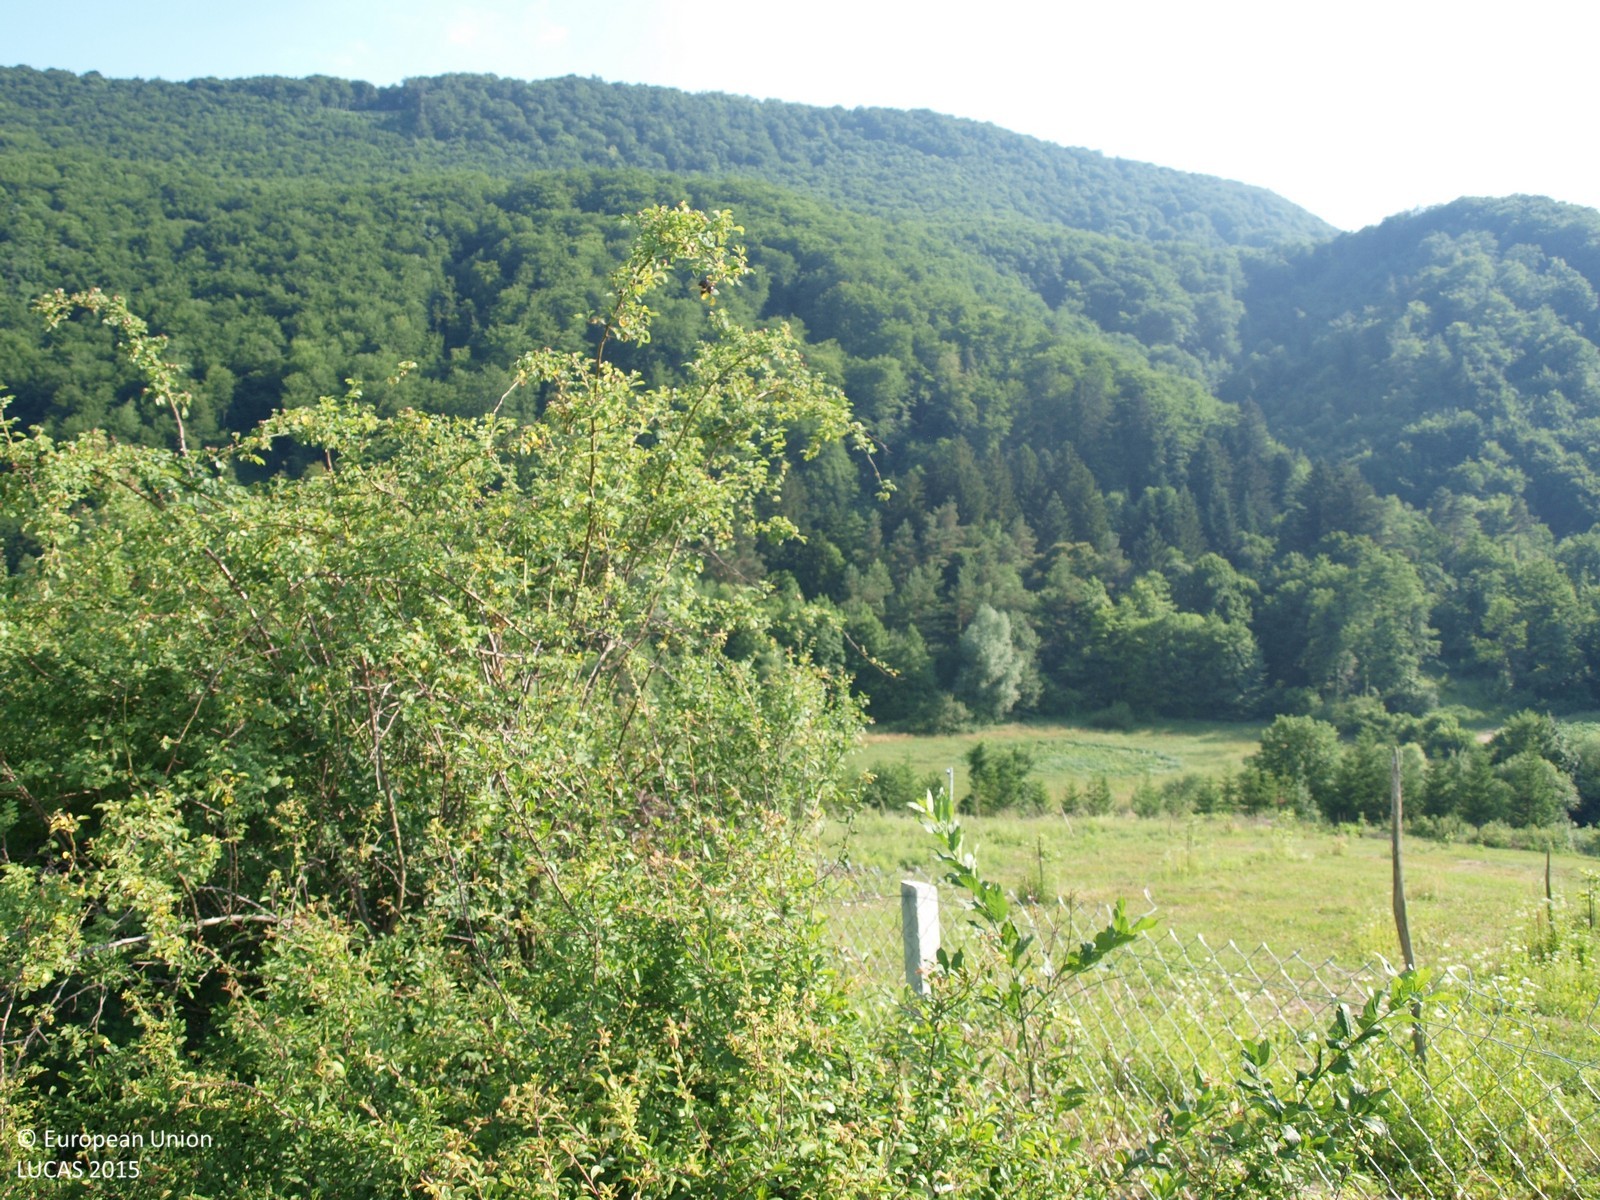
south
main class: Cropland
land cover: Nuts trees
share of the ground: 50 - 75 %
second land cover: Grassland without tree/shrub cover
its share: 50 - 75 %
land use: Agriculture (excluding fallow land and kitchen gardens)
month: June
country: HR
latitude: 46.2906
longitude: 16.0092
